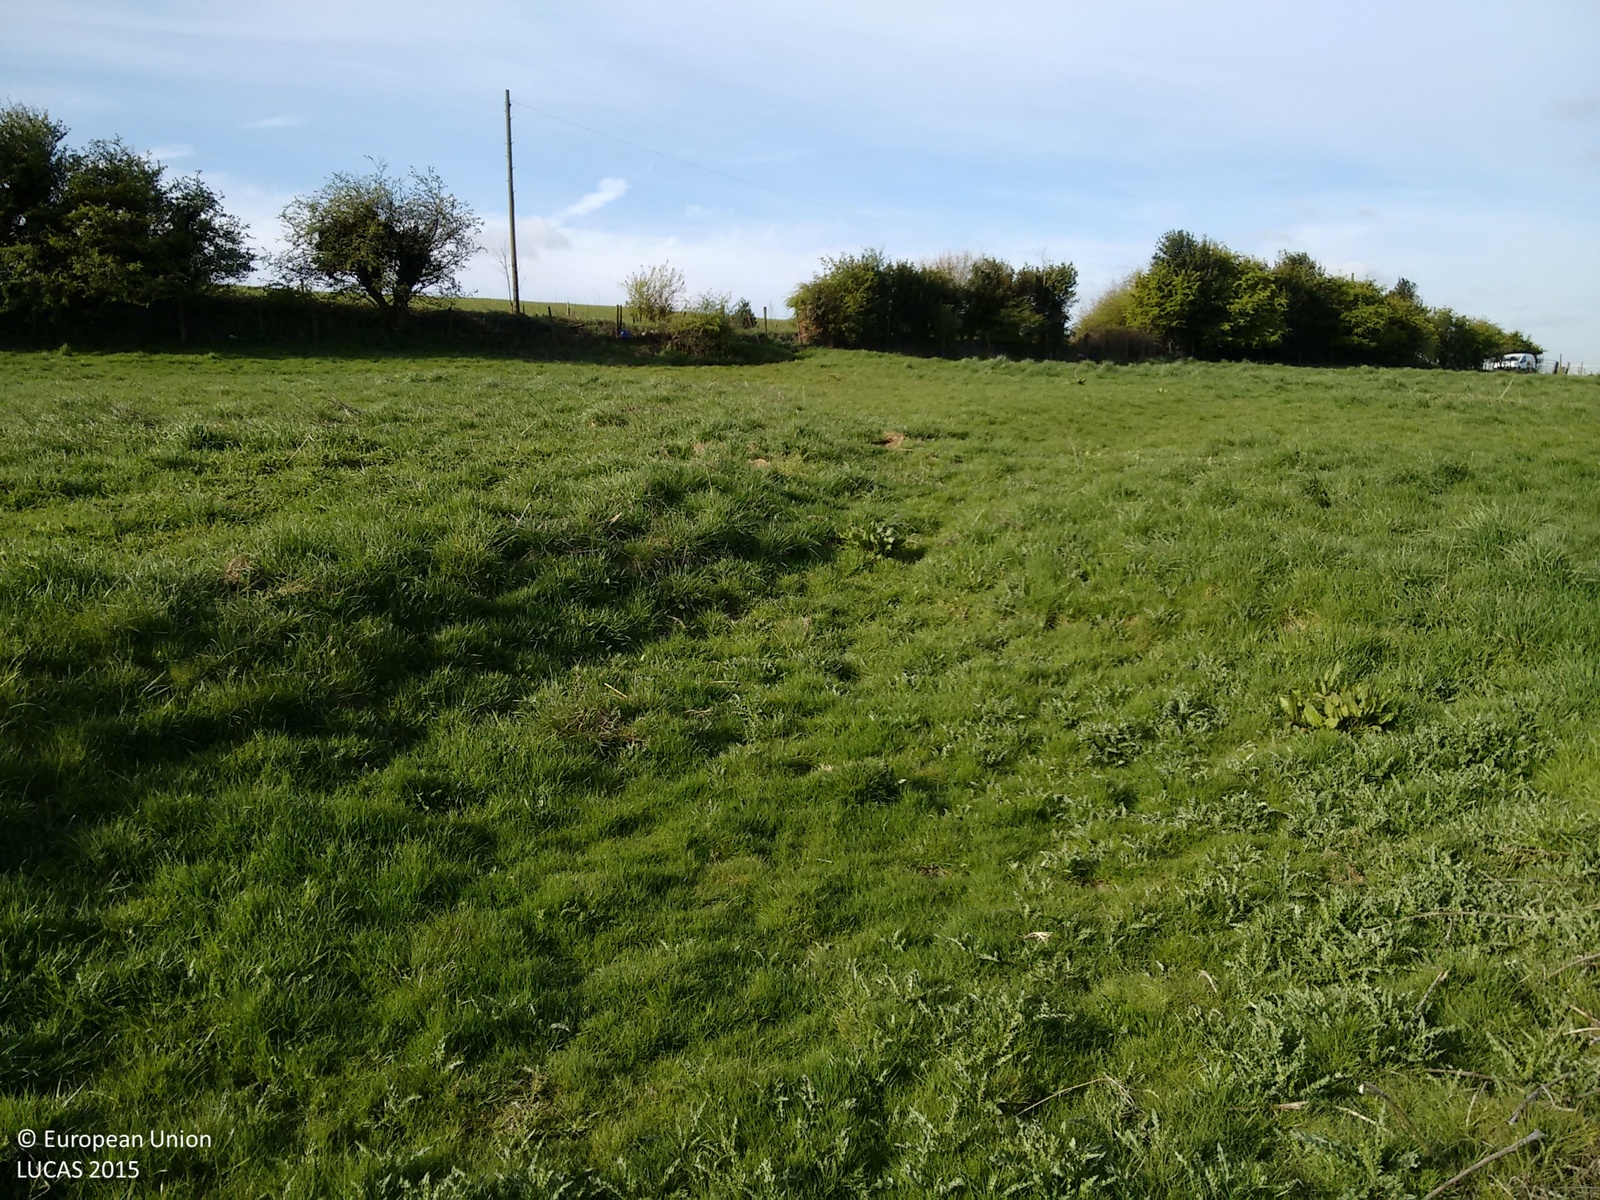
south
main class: Grassland
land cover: Grassland without tree/shrub cover
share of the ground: > 75 %
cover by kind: herbaceous plants 100 %
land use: Agriculture (excluding fallow land and kitchen gardens)
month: May
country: GB
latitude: 53.7578
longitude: -1.7168
